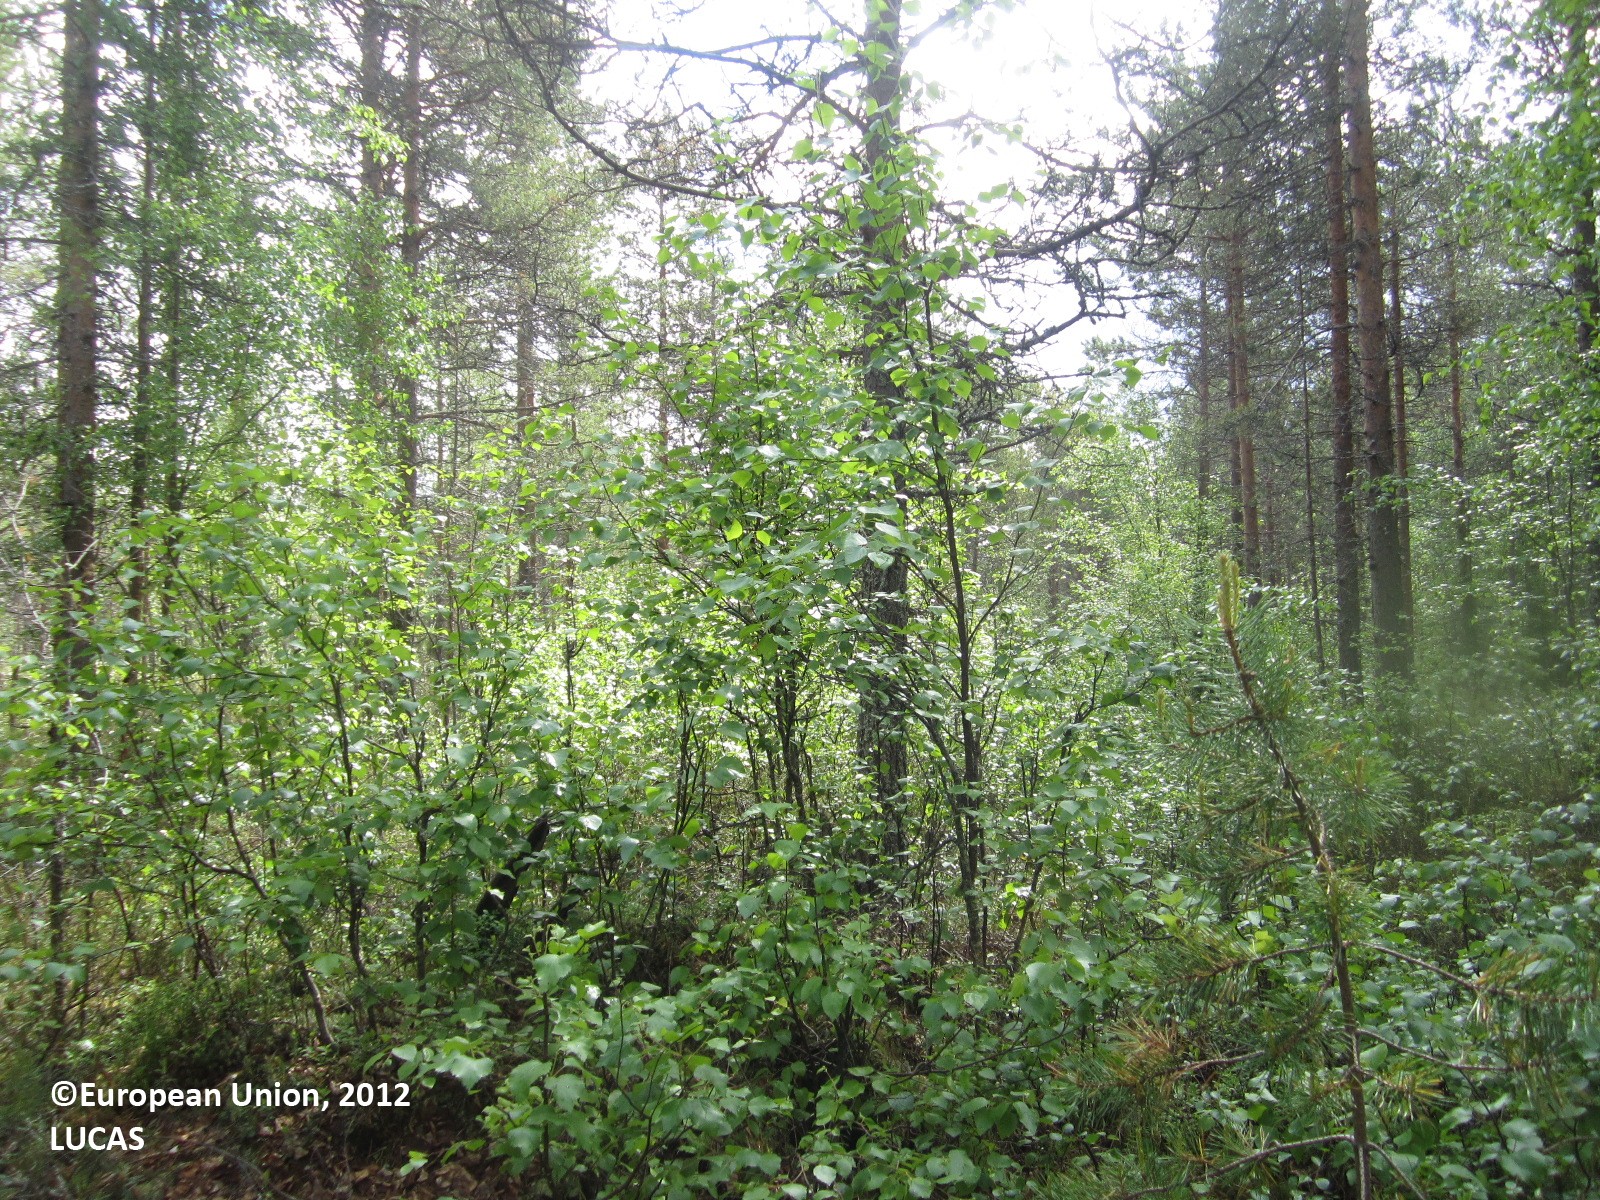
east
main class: Woodland
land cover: Pine dominated mixed woodland
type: boreal forest
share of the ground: 50 - 75 %
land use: Forestry
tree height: > 5 m
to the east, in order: Pine dominated mixed woodland; Pine dominated coniferous woodland; Ditches and canals; Pine dominated coniferous woodland; Ditches and canals; Pine dominated mixed woodland; Ditches and canals; Pine dominated coniferous woodland; Ditches and canals; Pine dominated coniferous woodland; Lichens and moss; Pine dominated coniferous woodland; Lichens and moss; Pine dominated coniferous woodland; Tracks; Pine dominated coniferous woodland
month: June
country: FI
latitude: 64.3885
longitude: 29.7785
